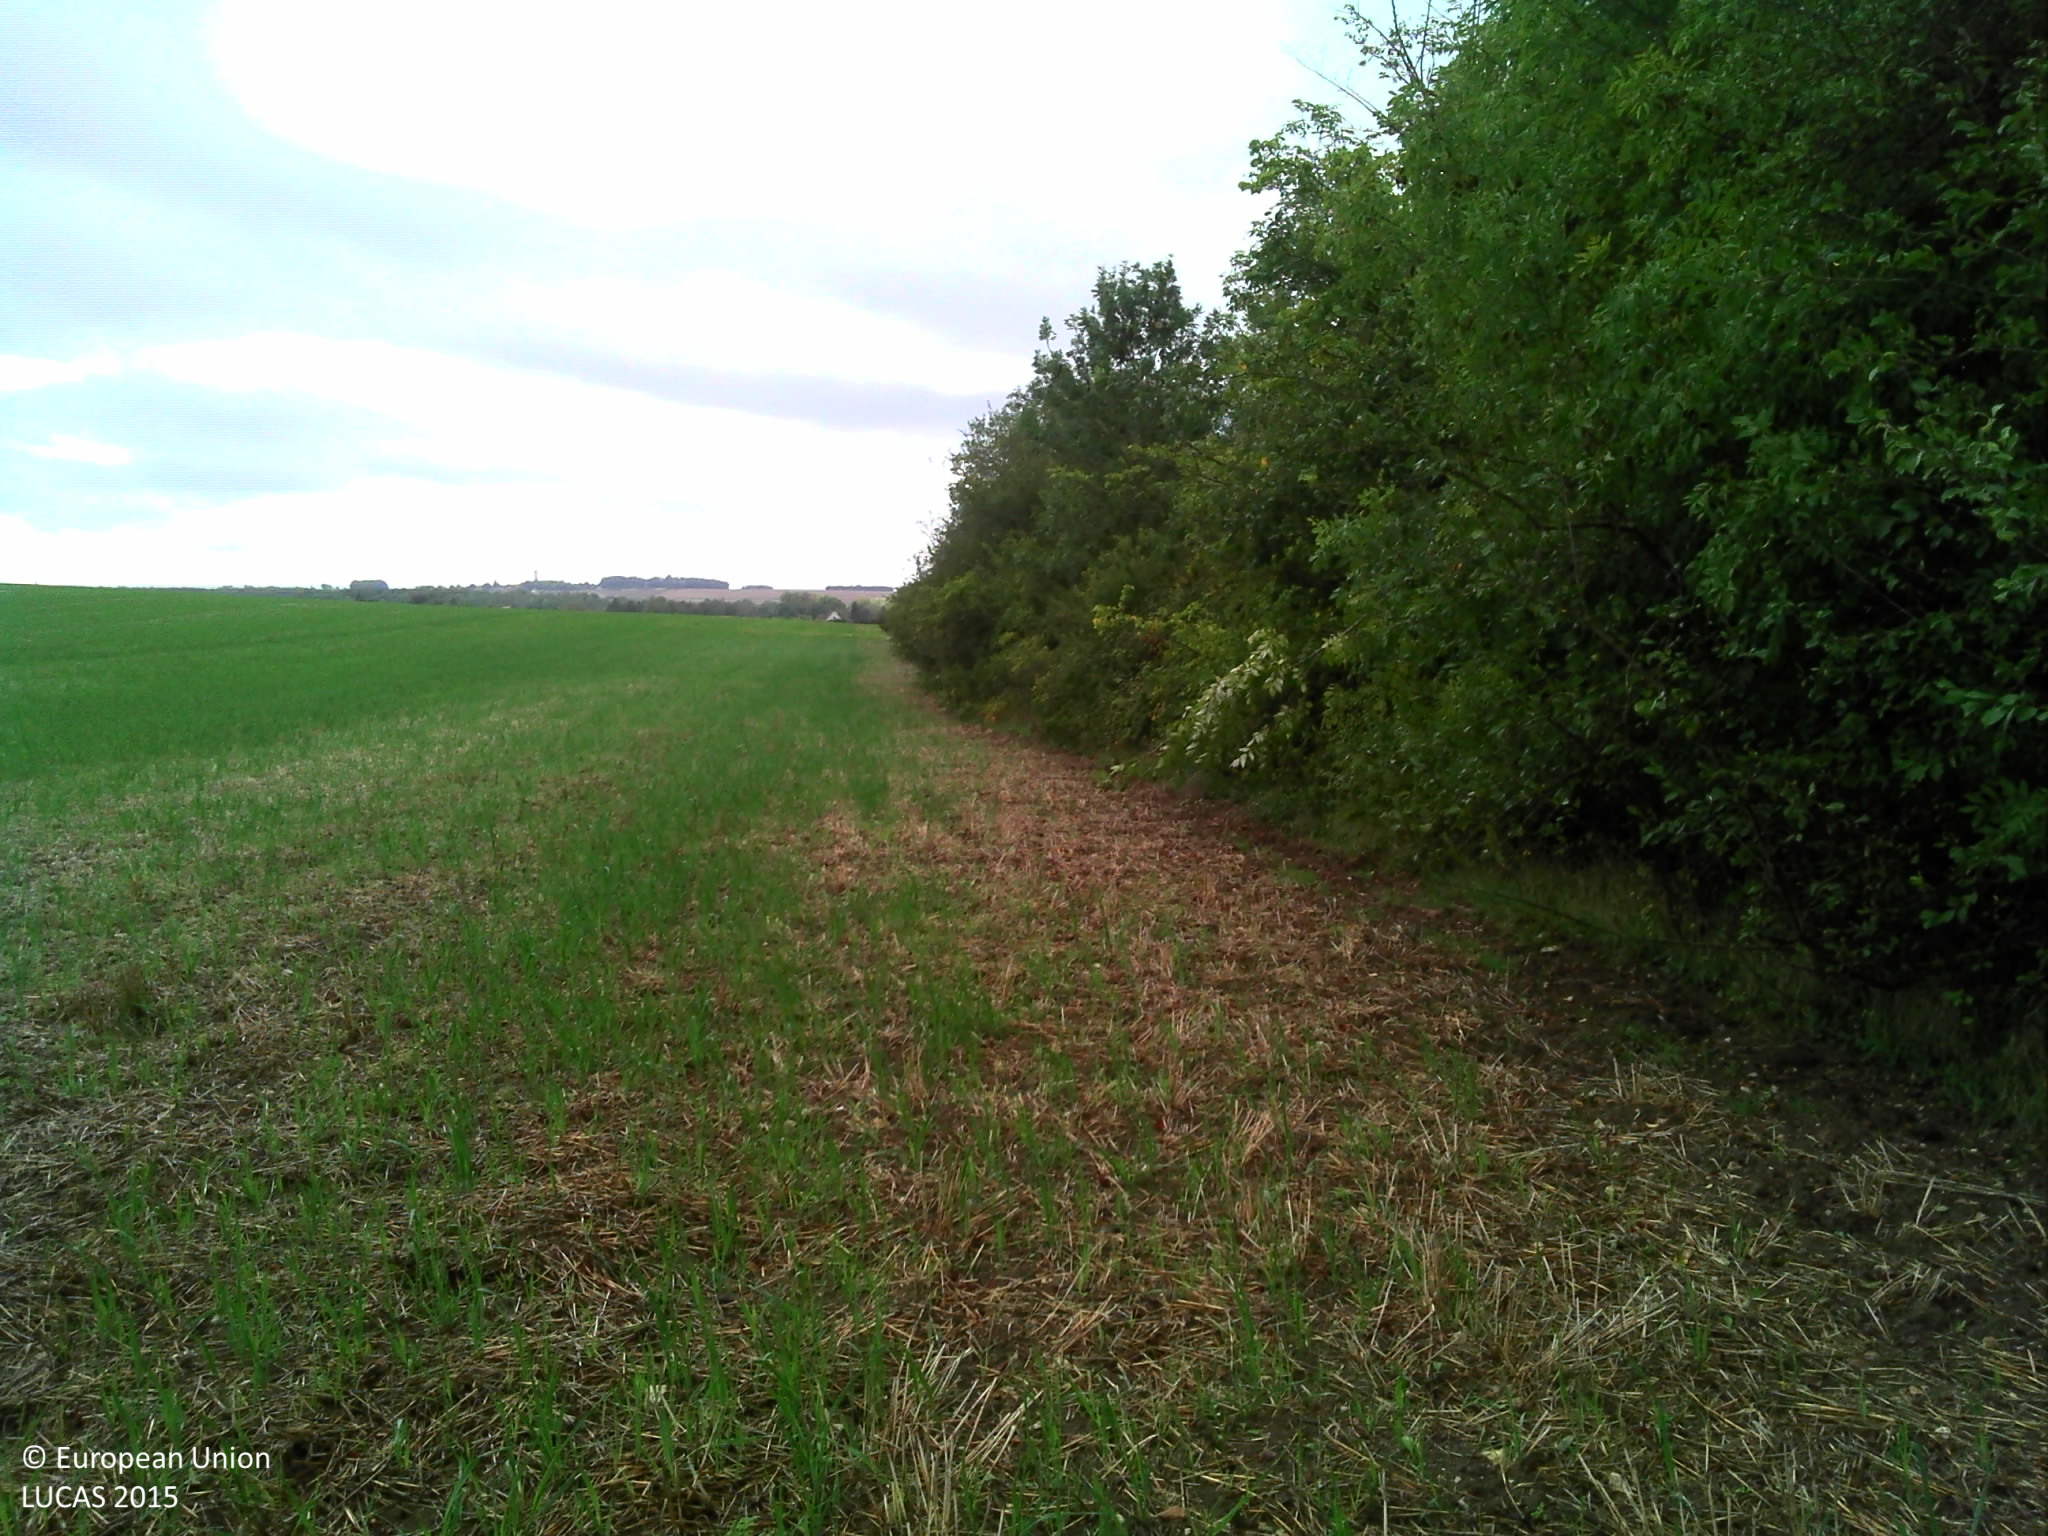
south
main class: Cropland
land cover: Common wheat
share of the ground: > 75 %
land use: Agriculture (excluding fallow land and kitchen gardens)
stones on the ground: < 10 %
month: September
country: FR
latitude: 48.4346
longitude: 3.0041
